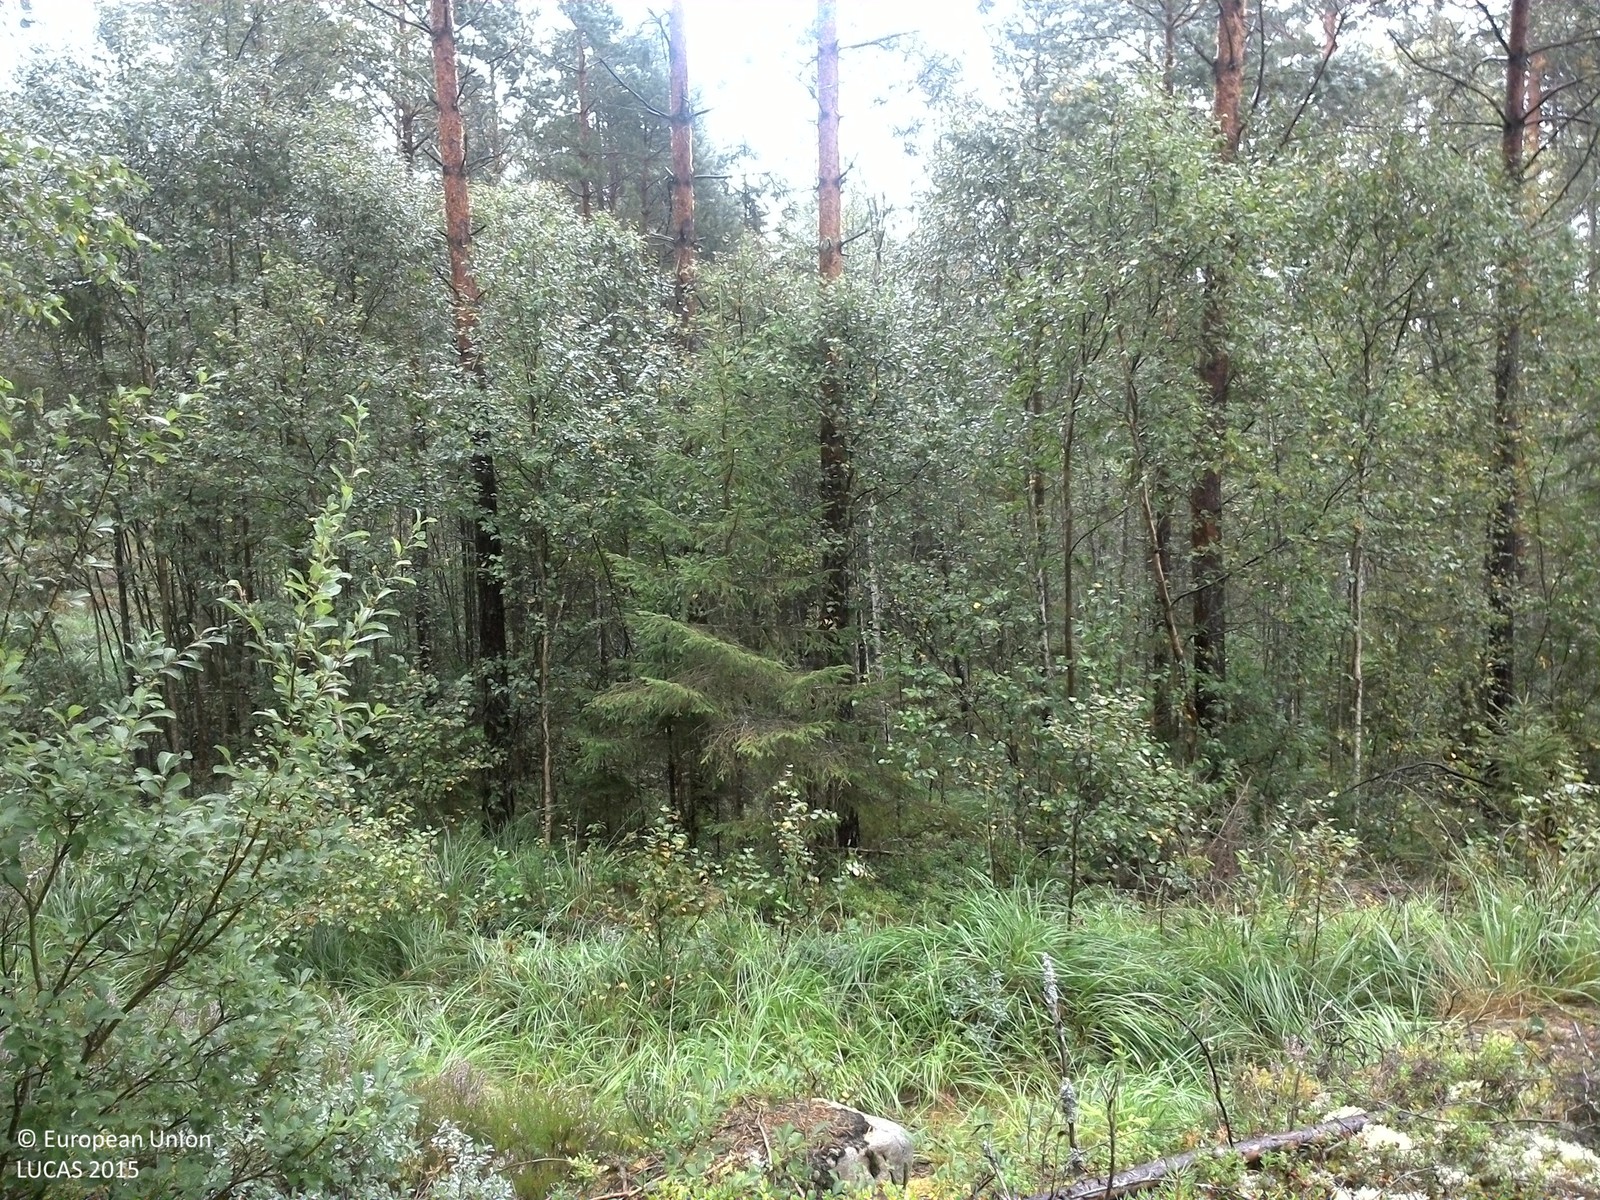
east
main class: Woodland
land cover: Pine dominated mixed woodland
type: boreal forest
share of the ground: 25 - 50 %
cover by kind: coniferous forest trees 30 %, broadleaved forest trees 20 %, shrubs 20 %, lichens and mosses 20 %, herbaceous plants 10 %
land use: Forestry
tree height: > 5 m
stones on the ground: 10 - 25 %
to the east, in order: Pine dominated mixed woodland; Tracks; Pine dominated coniferous woodland; Tracks; Pine dominated coniferous woodland; Rivers and streams; Pine dominated mixed woodland; Pine dominated coniferous woodland; Tracks; Pine dominated coniferous woodland
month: September
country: SE
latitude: 59.3375
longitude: 12.0517
